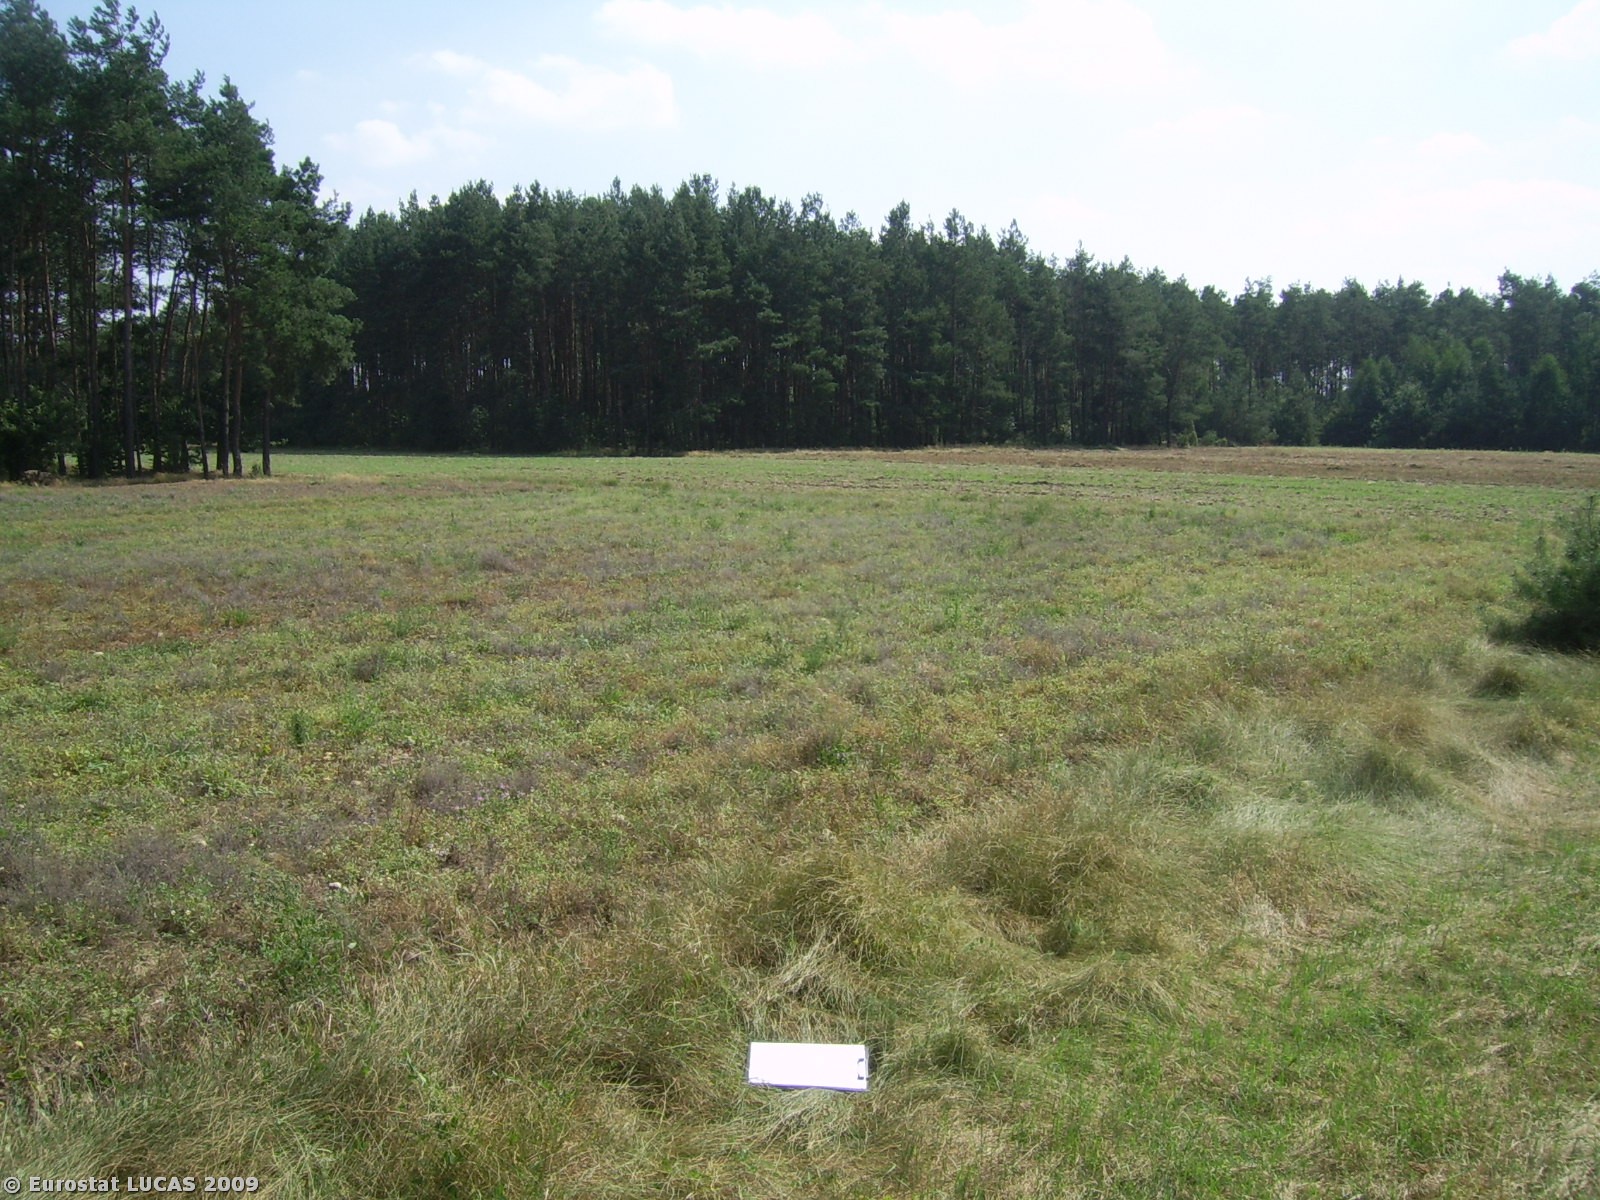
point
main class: Grassland
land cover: Grassland without tree/shrub cover
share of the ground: > 75 %
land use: Agriculture (excluding fallow land and kitchen gardens)
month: August
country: PL
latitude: 51.5134
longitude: 18.4778
